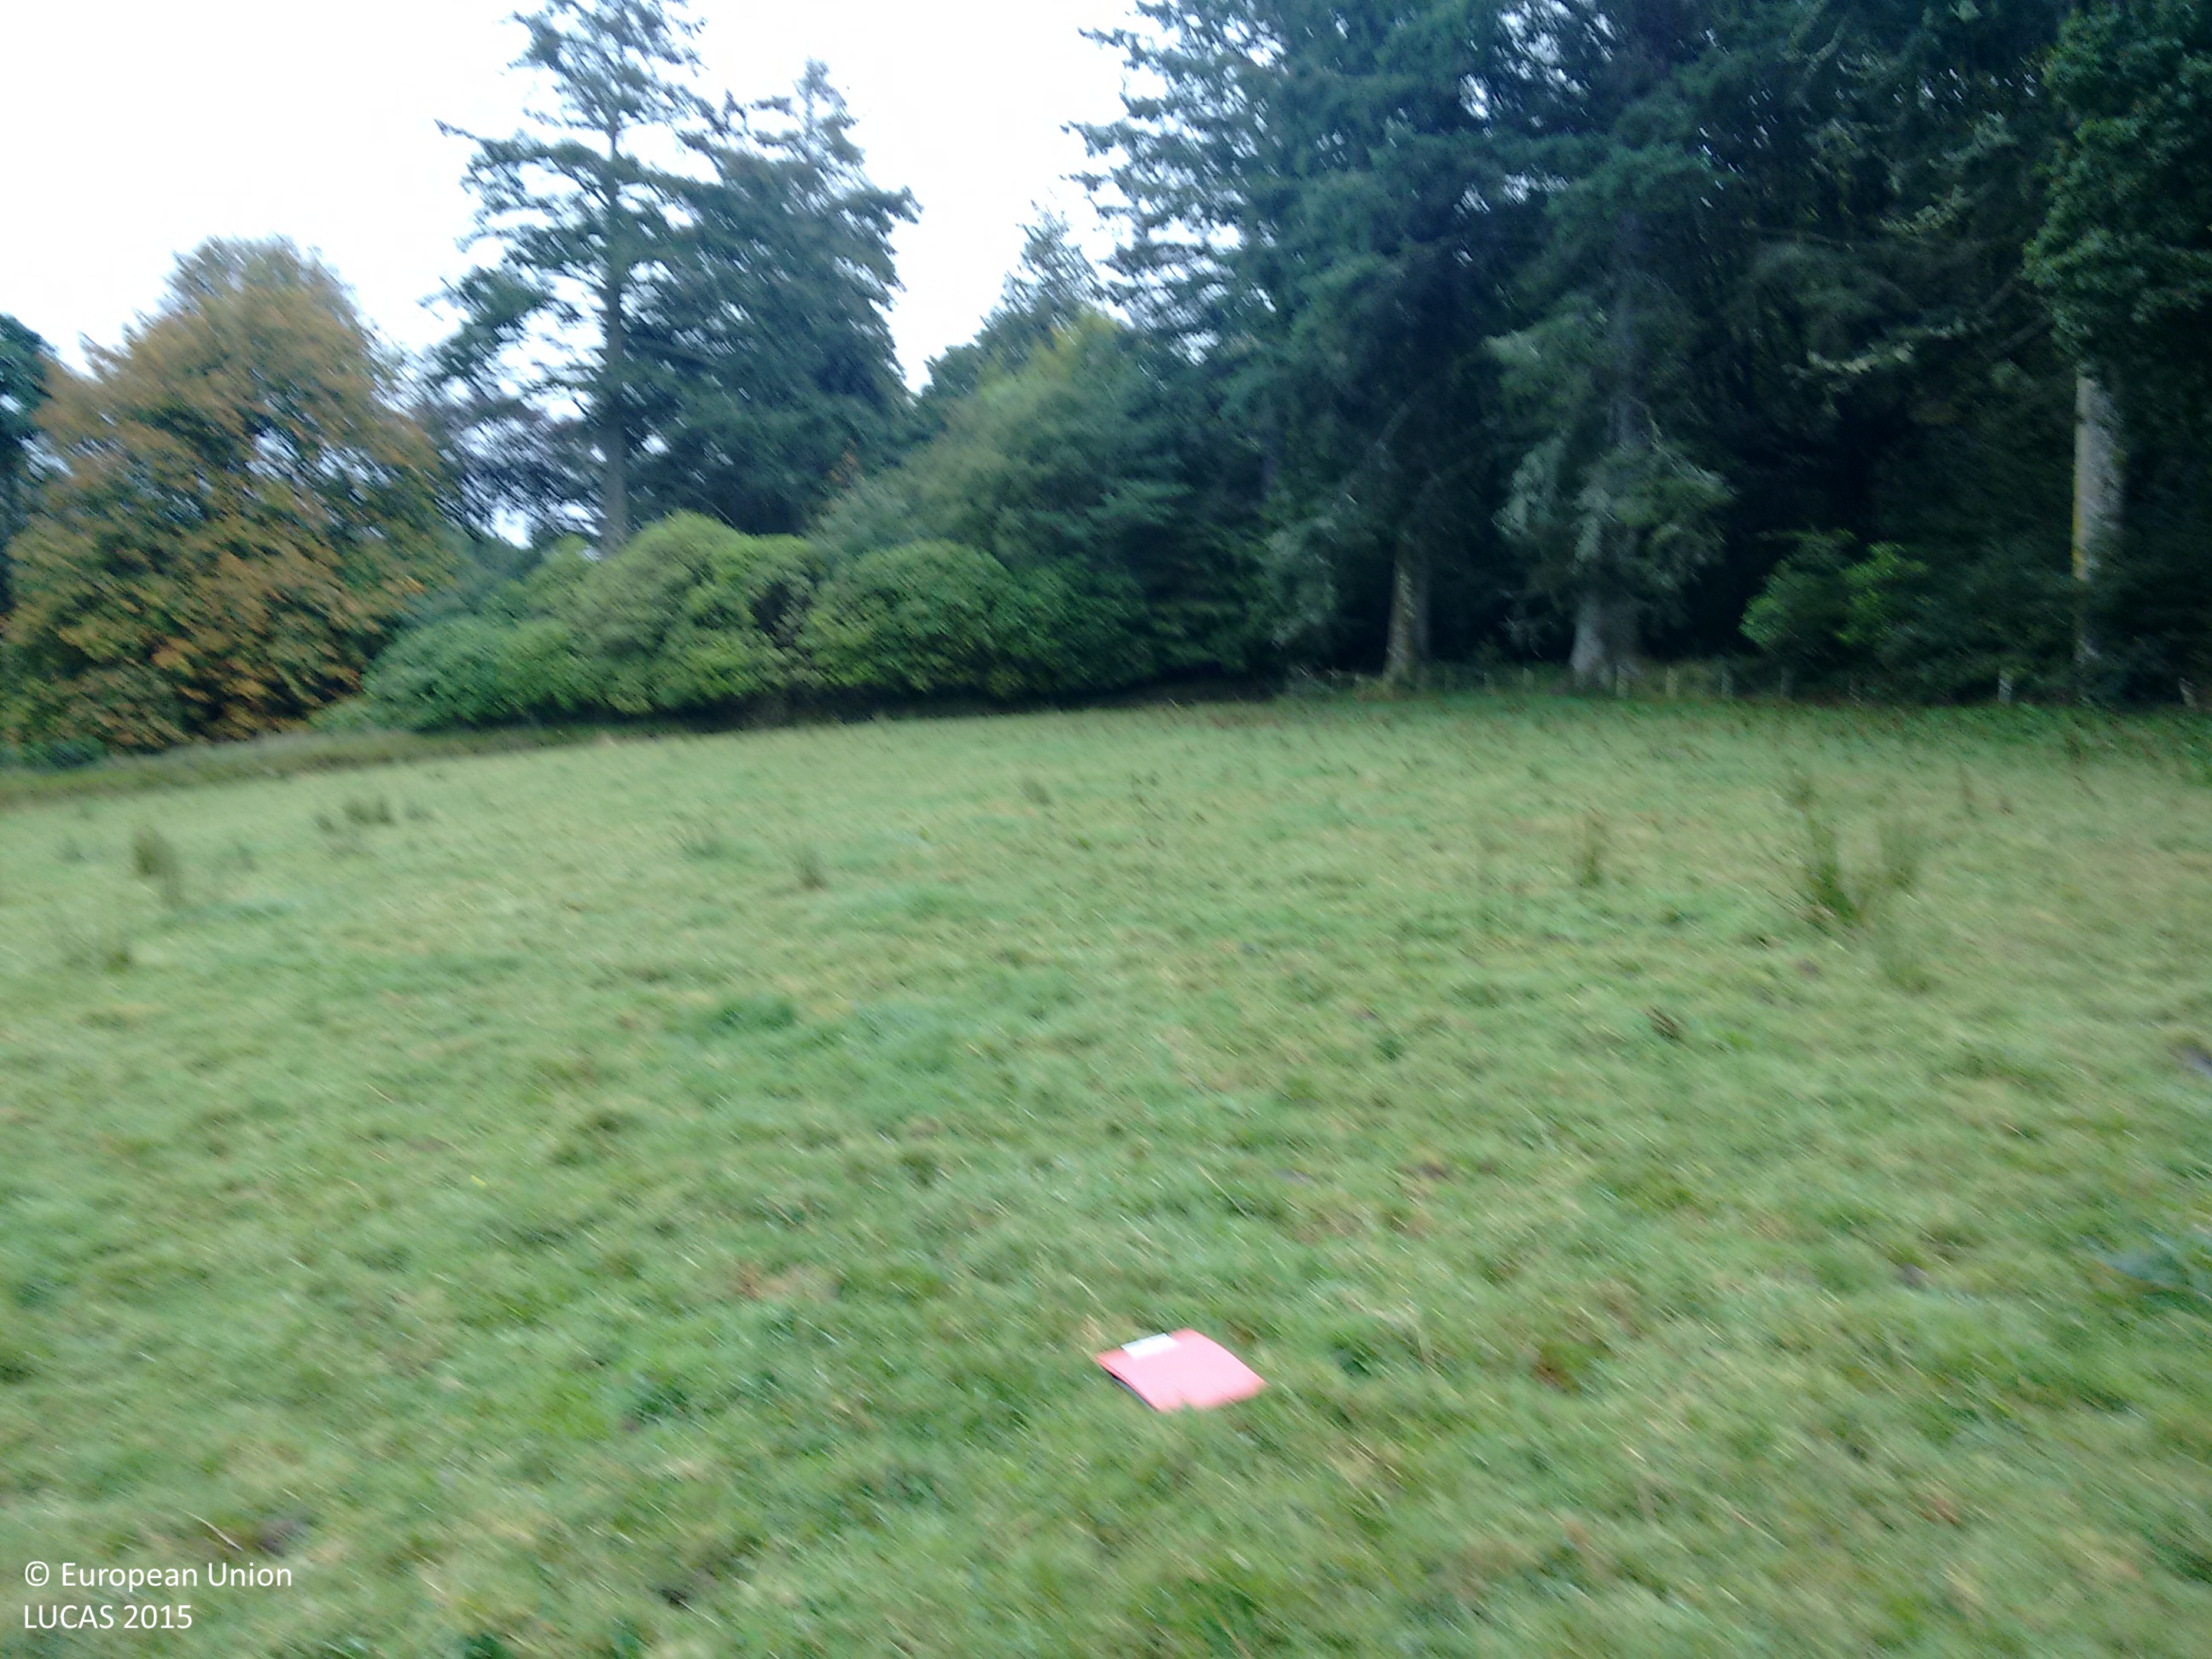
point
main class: Grassland
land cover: Grassland without tree/shrub cover
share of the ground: > 75 %
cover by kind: herbaceous plants 100 %
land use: Agriculture (excluding fallow land and kitchen gardens)
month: September
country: GB
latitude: 55.5300
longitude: -5.5078
